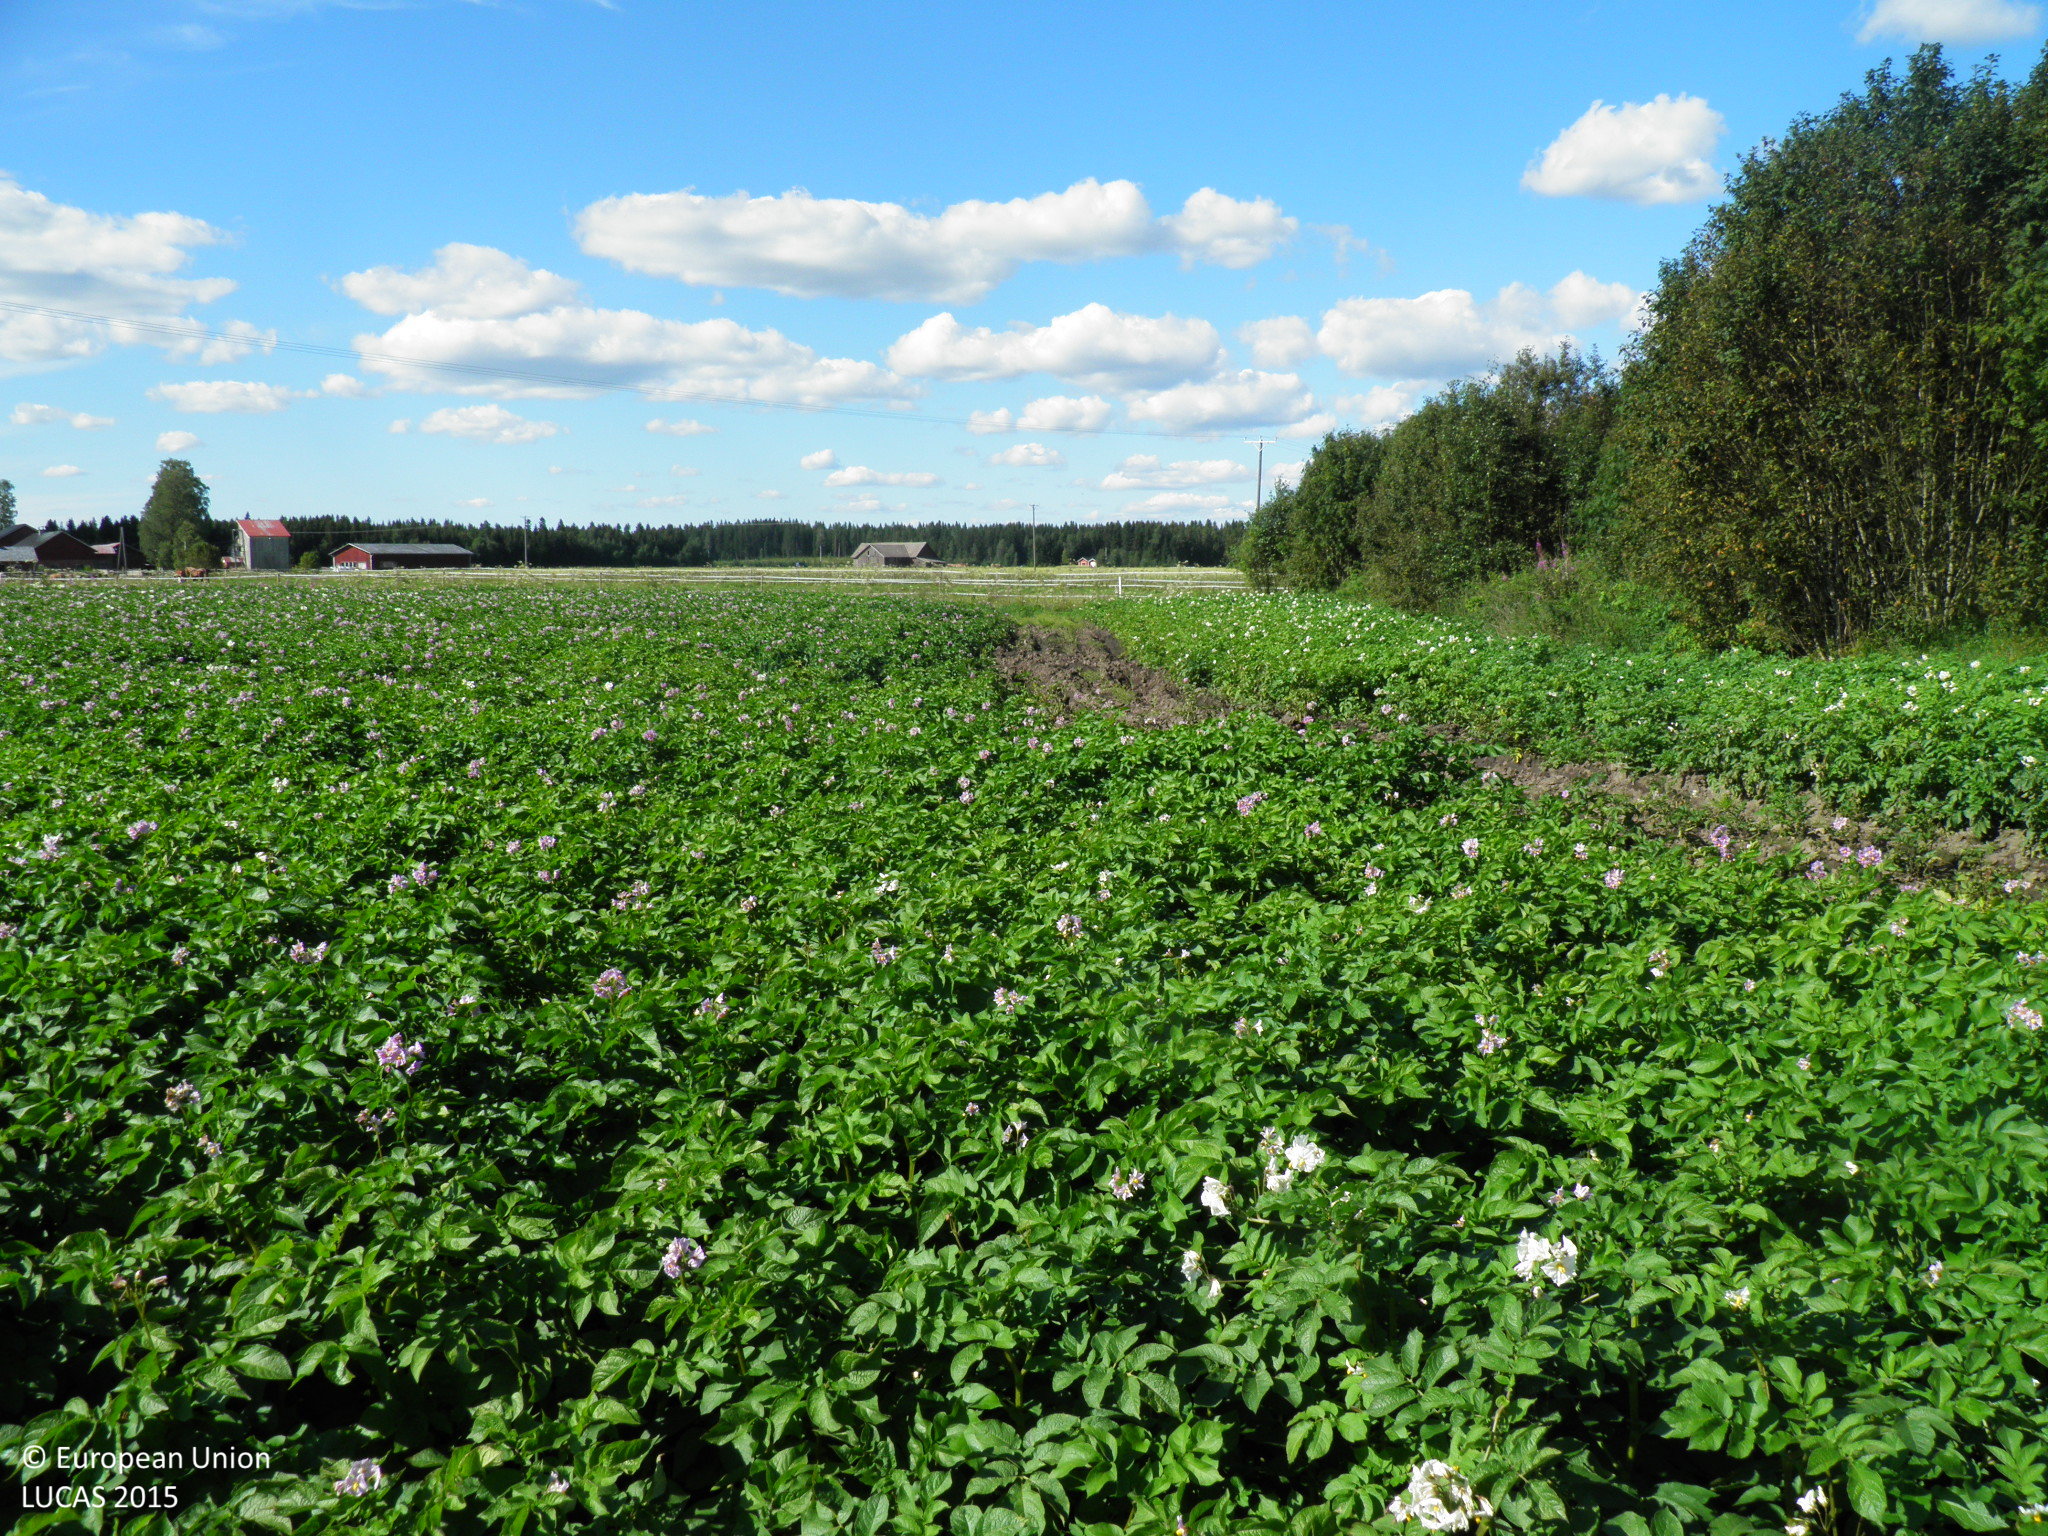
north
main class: Cropland
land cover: Potatoes
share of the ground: > 75 %
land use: Agriculture (excluding fallow land and kitchen gardens)
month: August
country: FI
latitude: 61.0796
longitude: 22.5426
